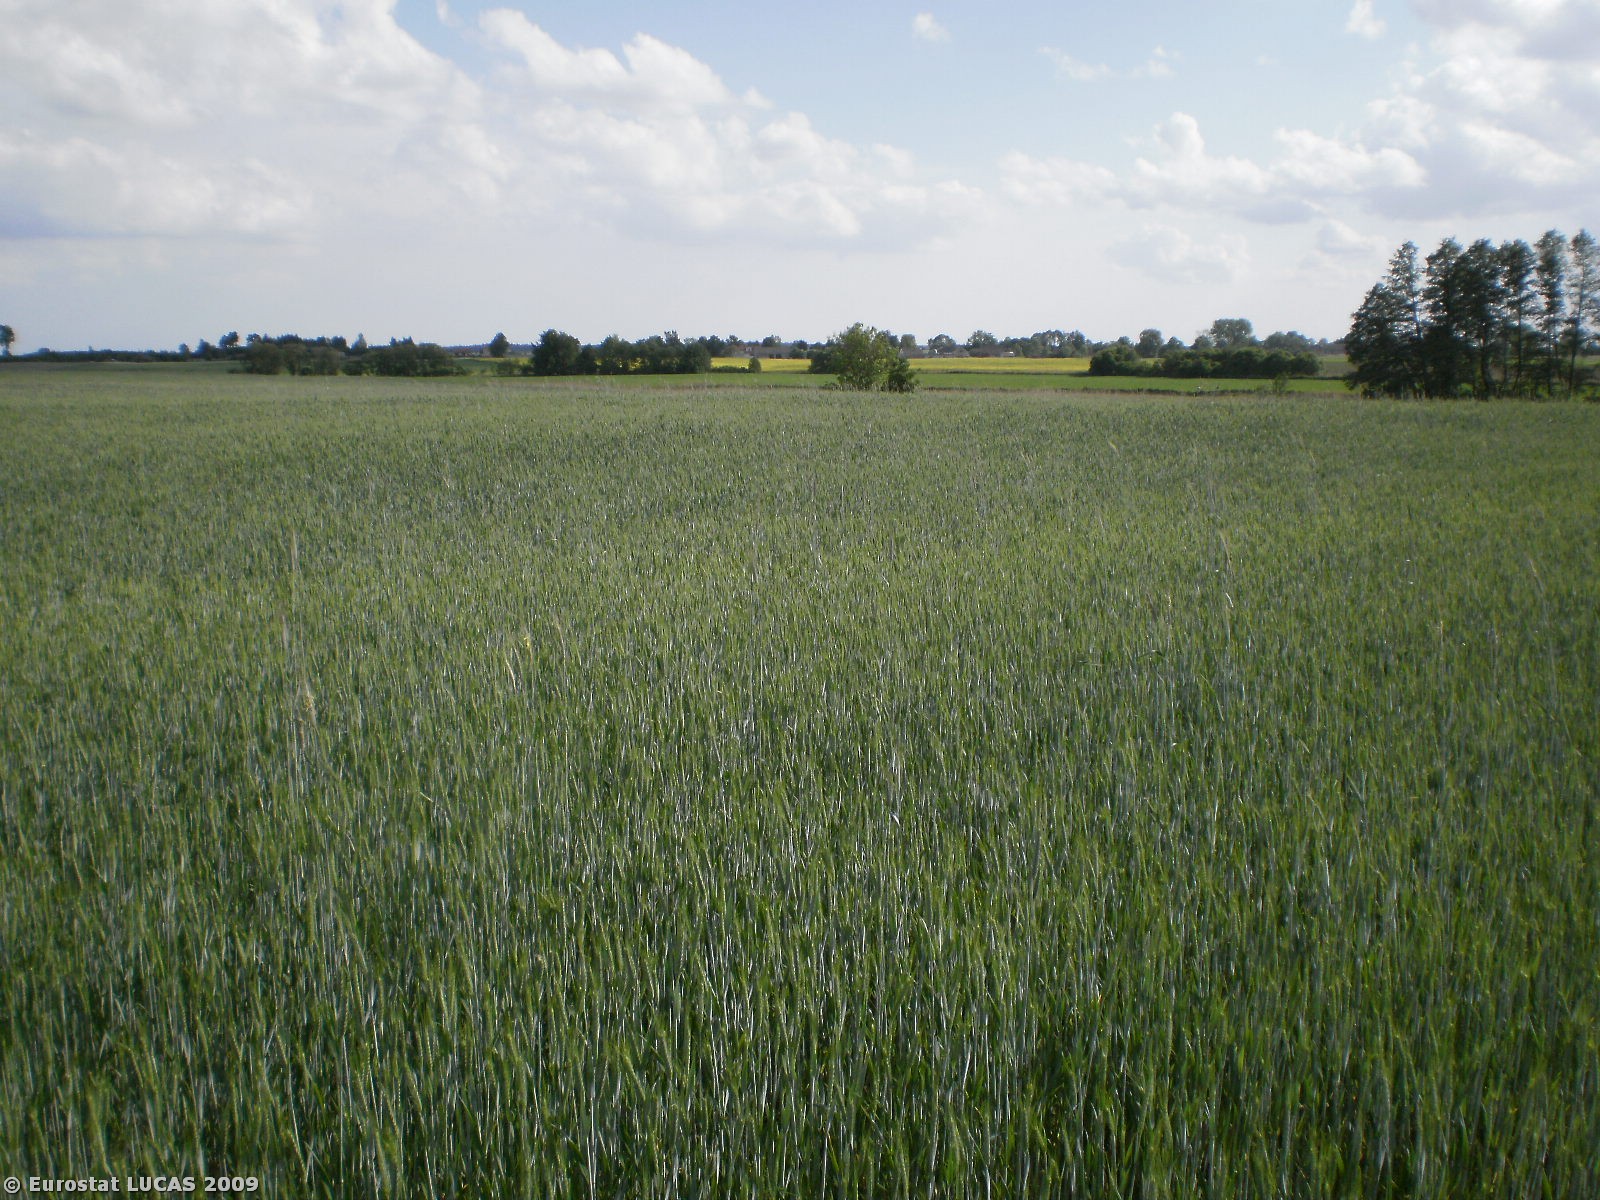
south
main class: Cropland
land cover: Triticale
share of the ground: > 75 %
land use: Agriculture (excluding fallow land and kitchen gardens)
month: May
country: PL
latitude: 53.2826
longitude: 17.7075
